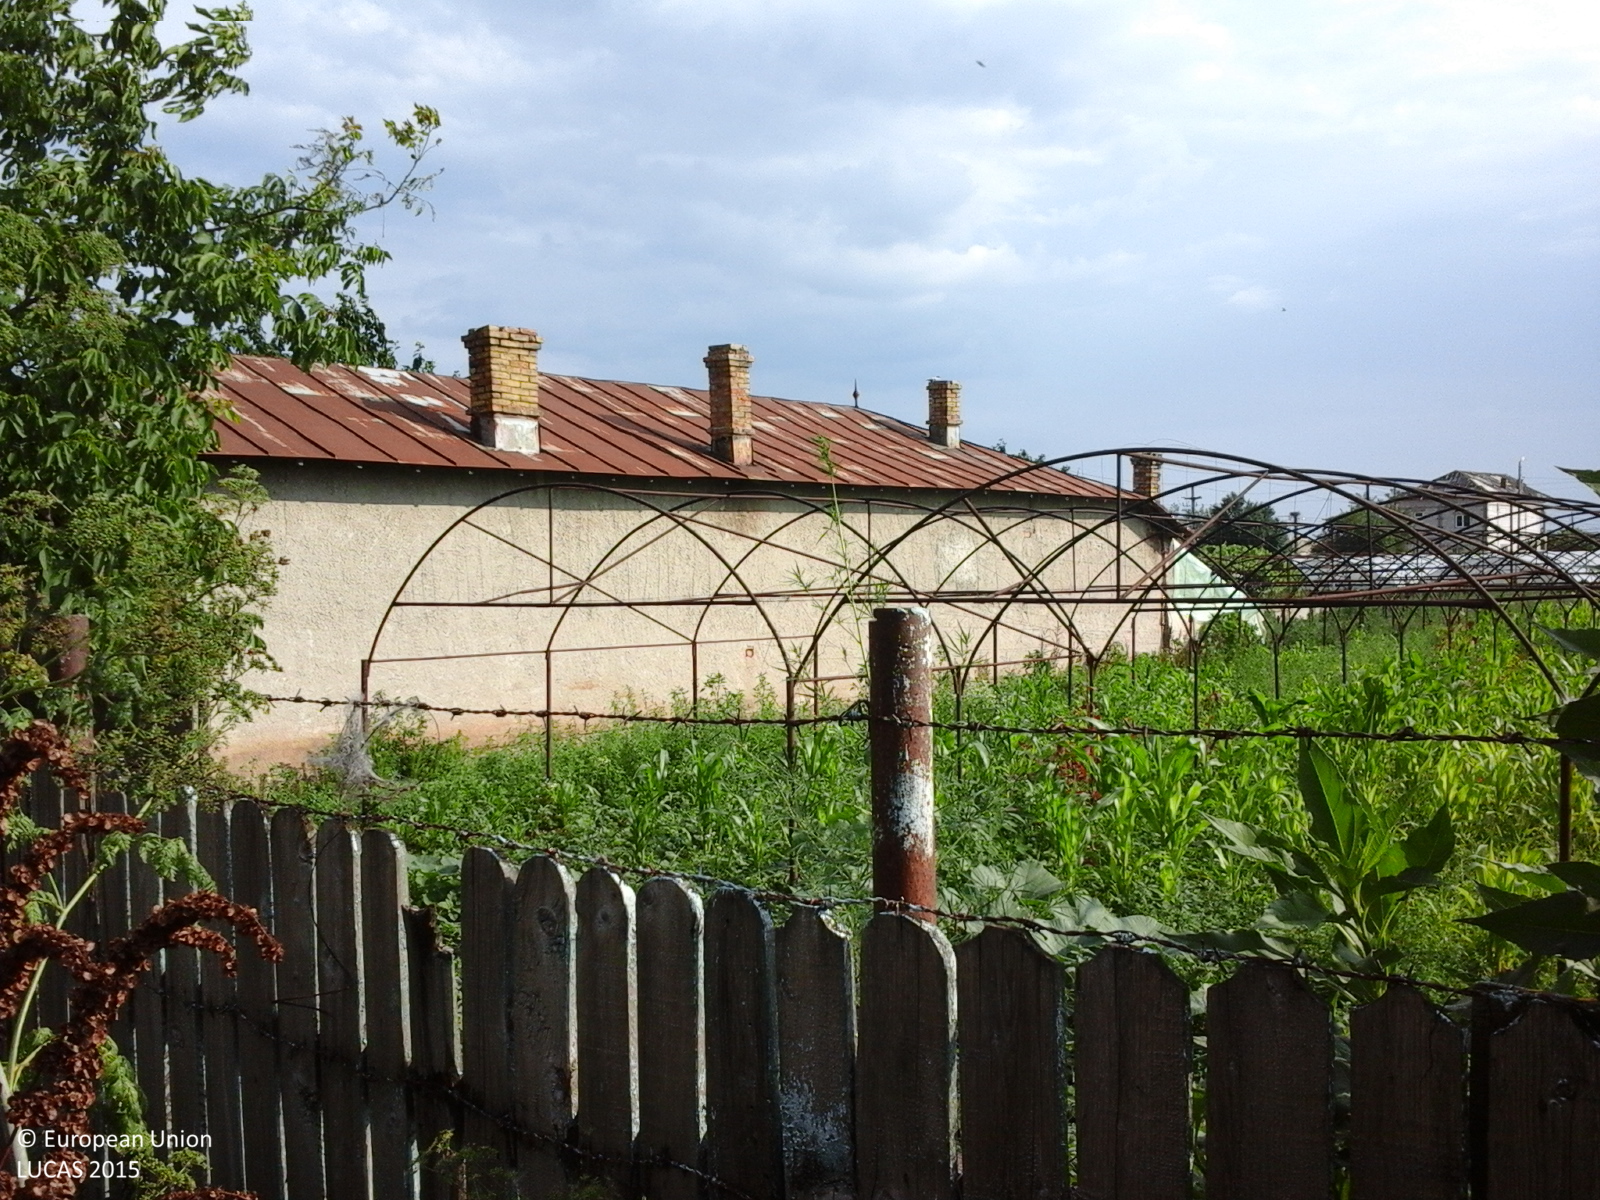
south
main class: Cropland
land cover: Maize
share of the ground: > 75 %
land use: Agriculture (excluding fallow land and kitchen gardens)
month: June
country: RO
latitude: 44.3116
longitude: 26.1134
